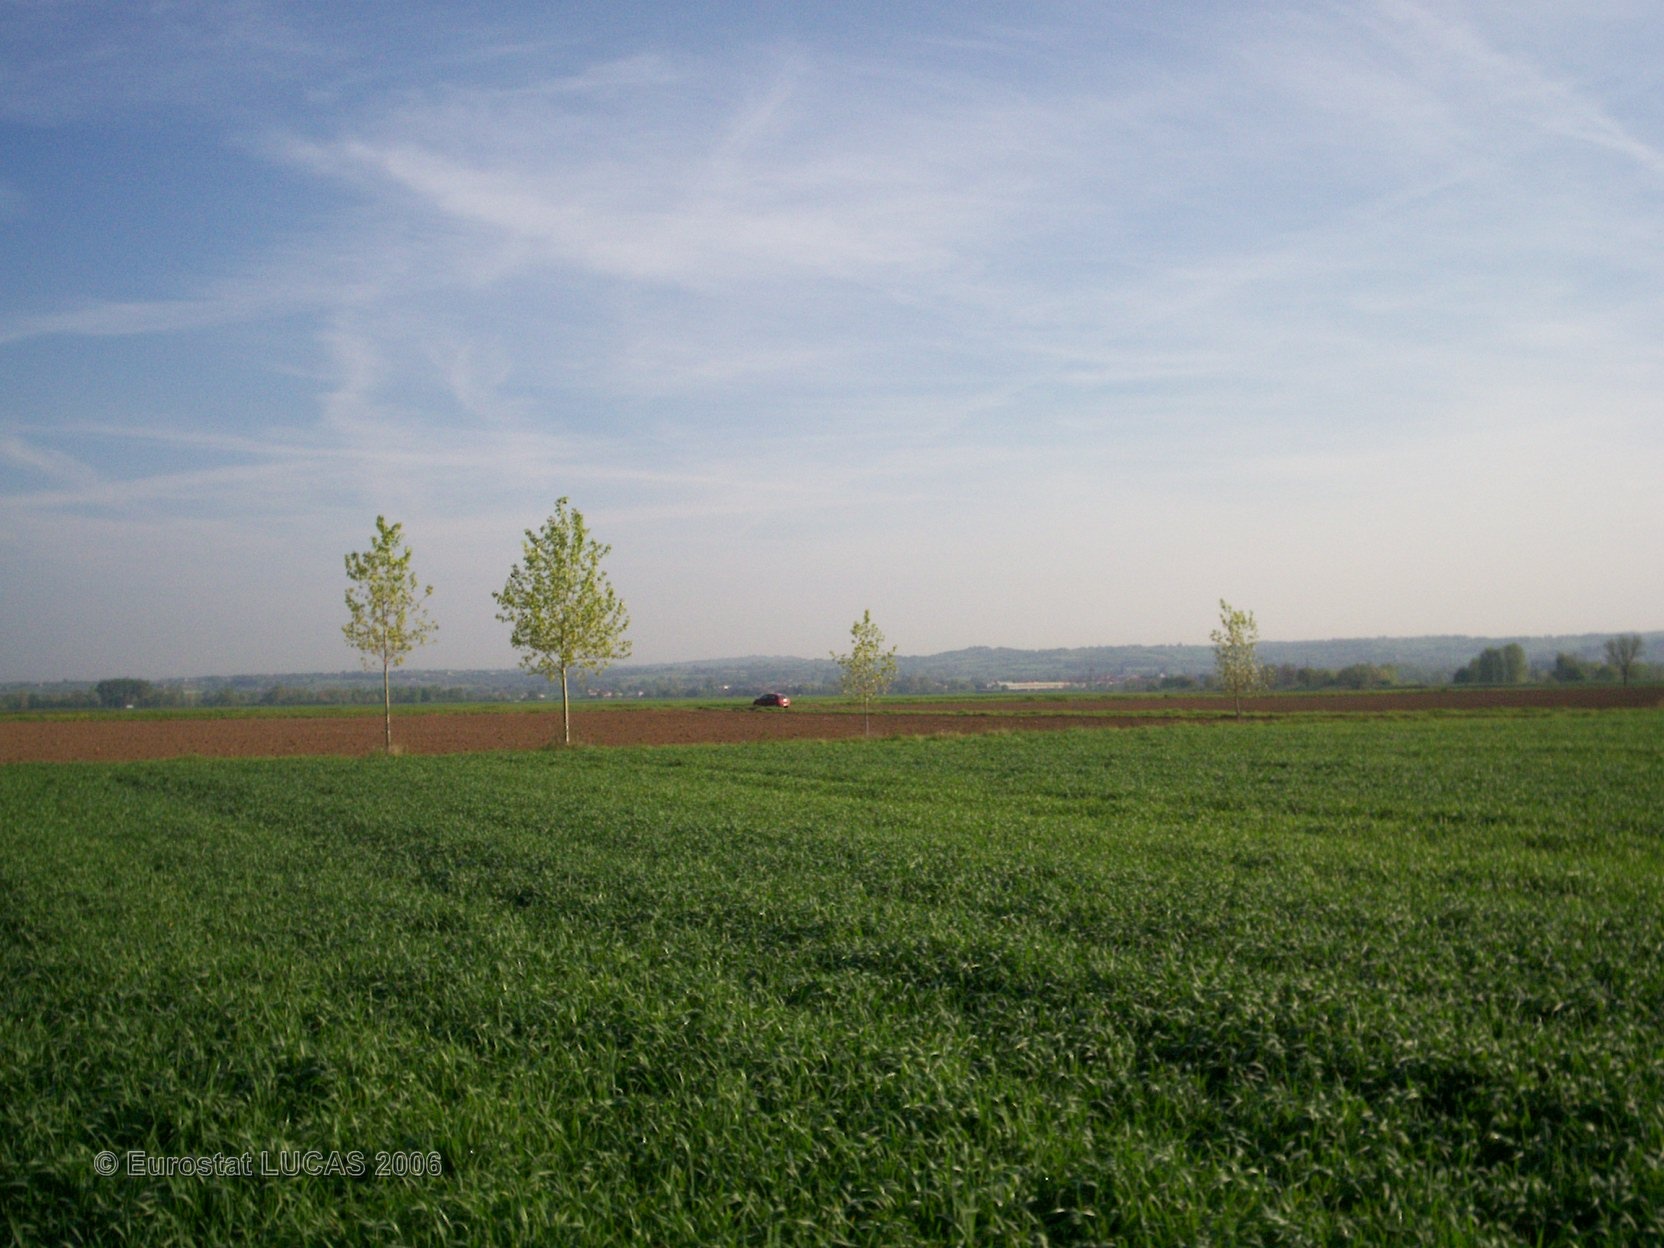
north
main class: Cropland
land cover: Common wheat
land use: Agriculture (excluding fallow land and kitchen gardens)
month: May
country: FR
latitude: 45.7951
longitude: 4.1746
